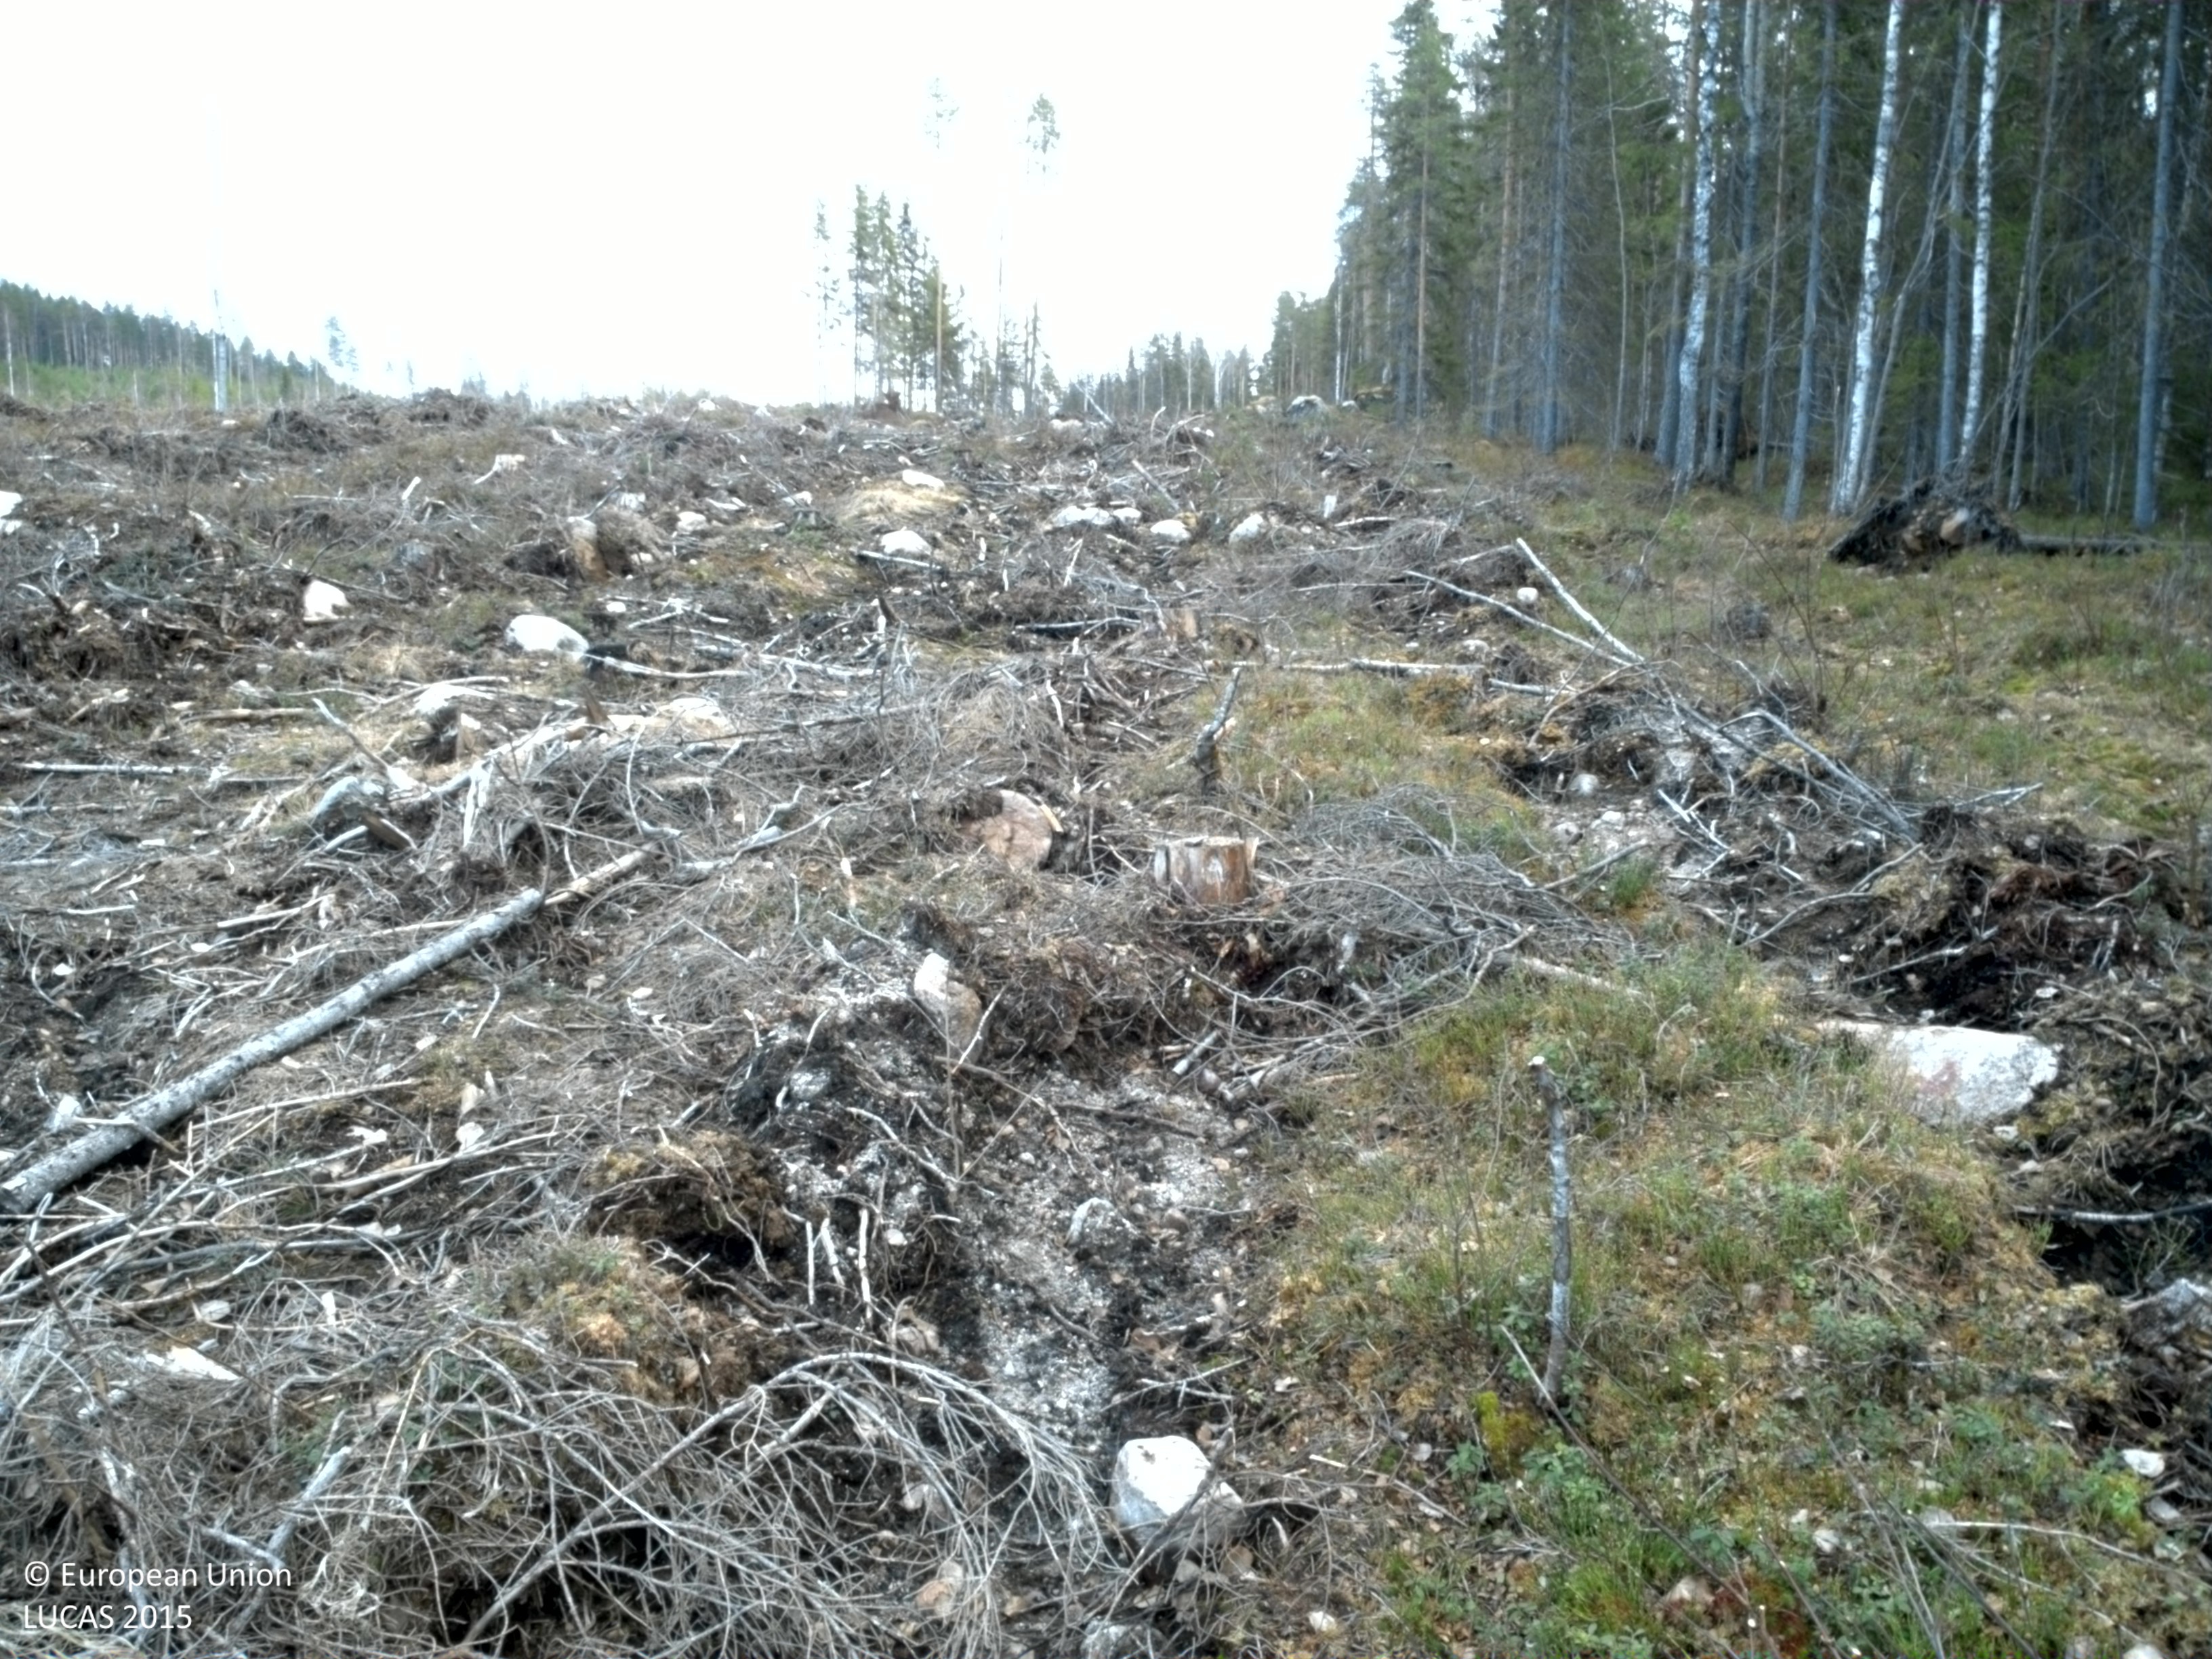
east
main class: Shrubland
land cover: Shrubland with sparse tree cover
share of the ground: 10 - 25 %
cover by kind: shrubs 20 %, unconsolidated bare surface 15 %, broadleaved forest trees 5 %, lichens and mosses 5 %
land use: Forestry
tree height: < 5 m
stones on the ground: 10 - 25 %
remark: Clear cut
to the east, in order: Shrubland with sparse tree cover
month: May
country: SE
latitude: 66.3358
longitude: 23.5395
